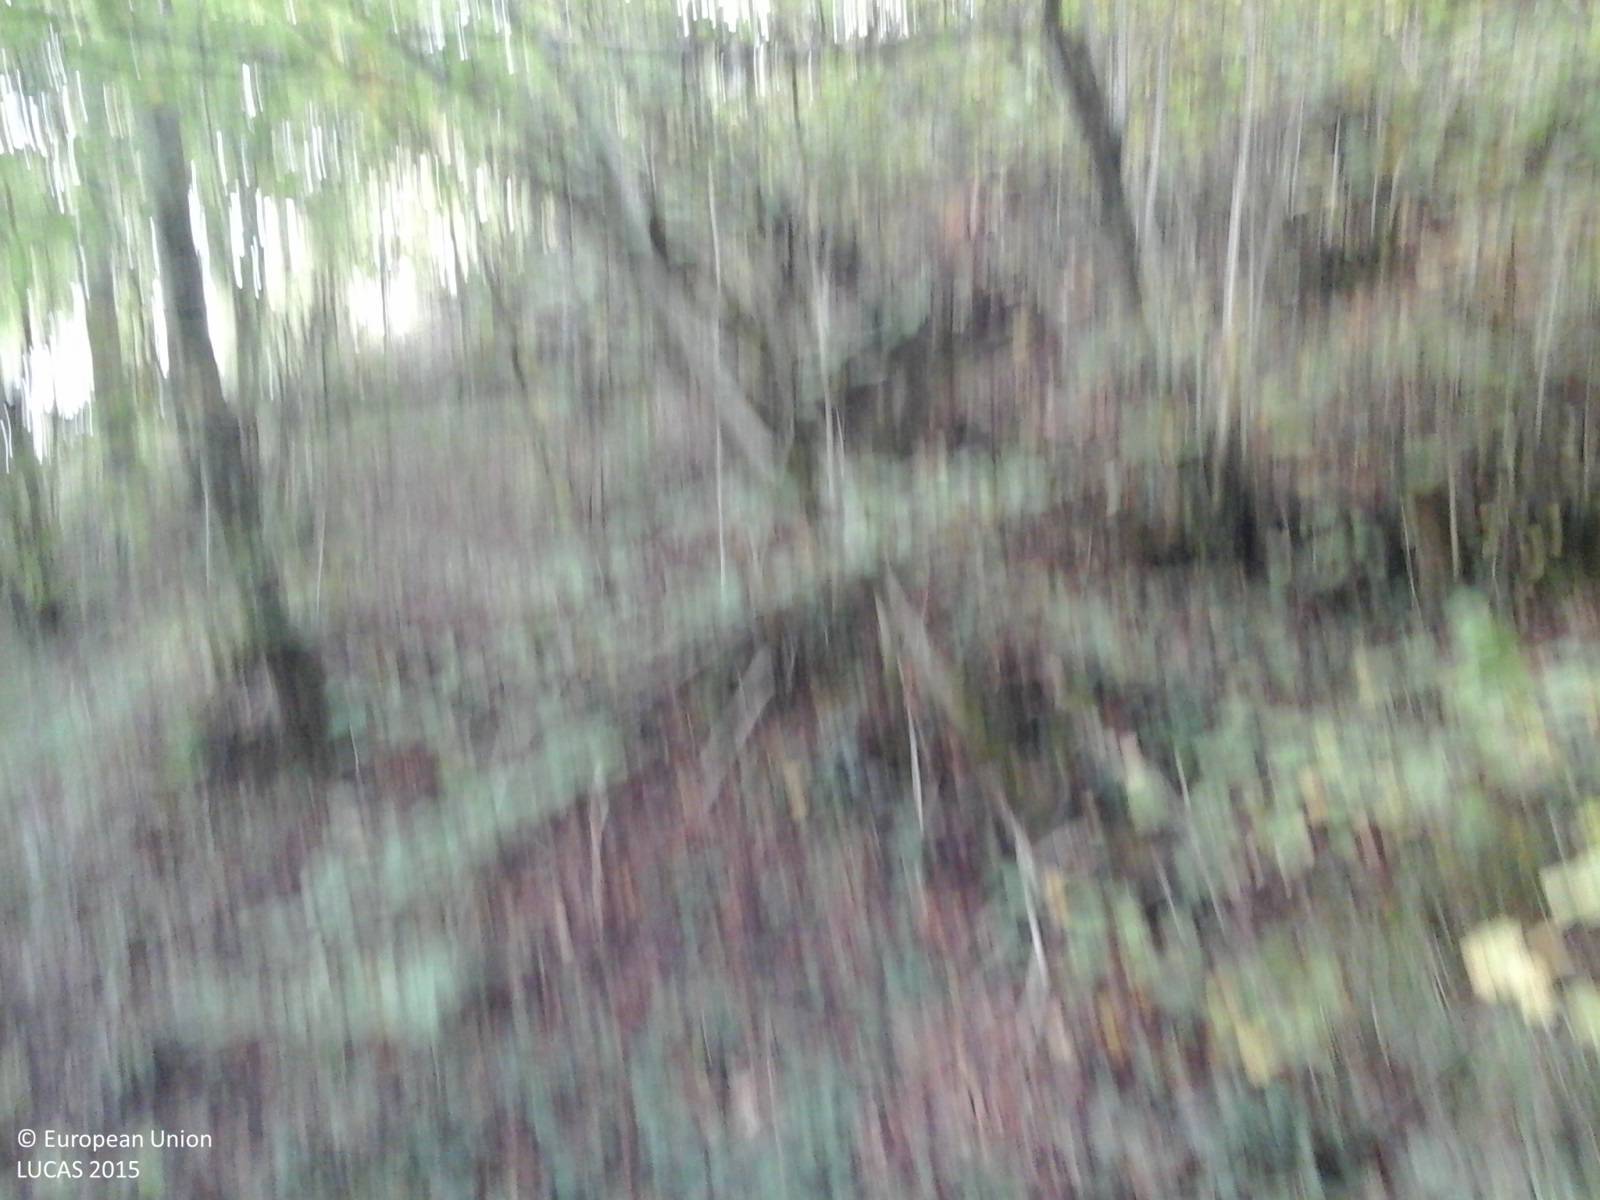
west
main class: Woodland
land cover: Broadleaved woodland
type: thermophilous deciduous forest
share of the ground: > 75 %
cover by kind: broadleaved forest trees 100 %
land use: Forestry
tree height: > 5 m
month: October
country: IT
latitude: 42.5142
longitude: 13.1667
